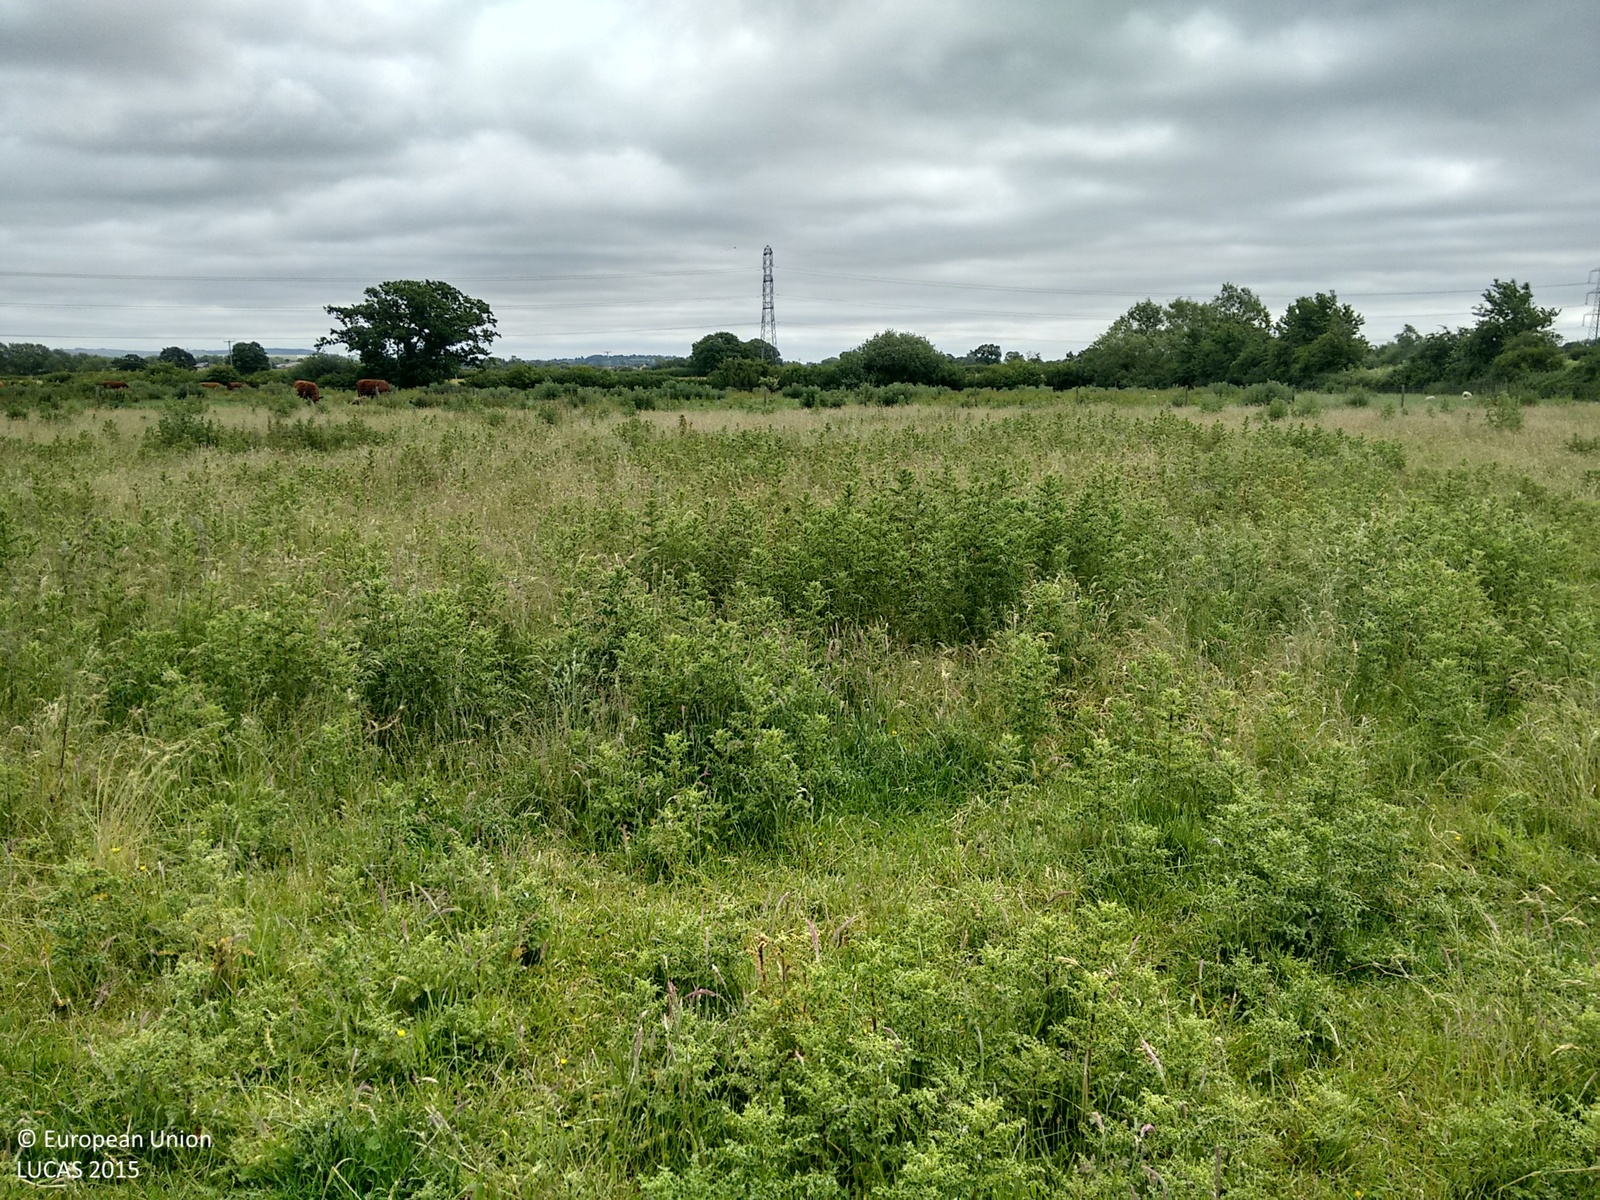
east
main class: Grassland
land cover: Grassland without tree/shrub cover
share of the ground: > 75 %
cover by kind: herbaceous plants 100 %
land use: Agriculture (excluding fallow land and kitchen gardens)
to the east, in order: Grassland without tree/shrub cover; Fences; Grassland without tree/shrub cover; Managed hedges; Arable land (only in case pi)
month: June
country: GB
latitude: 51.3488
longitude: -2.1648
